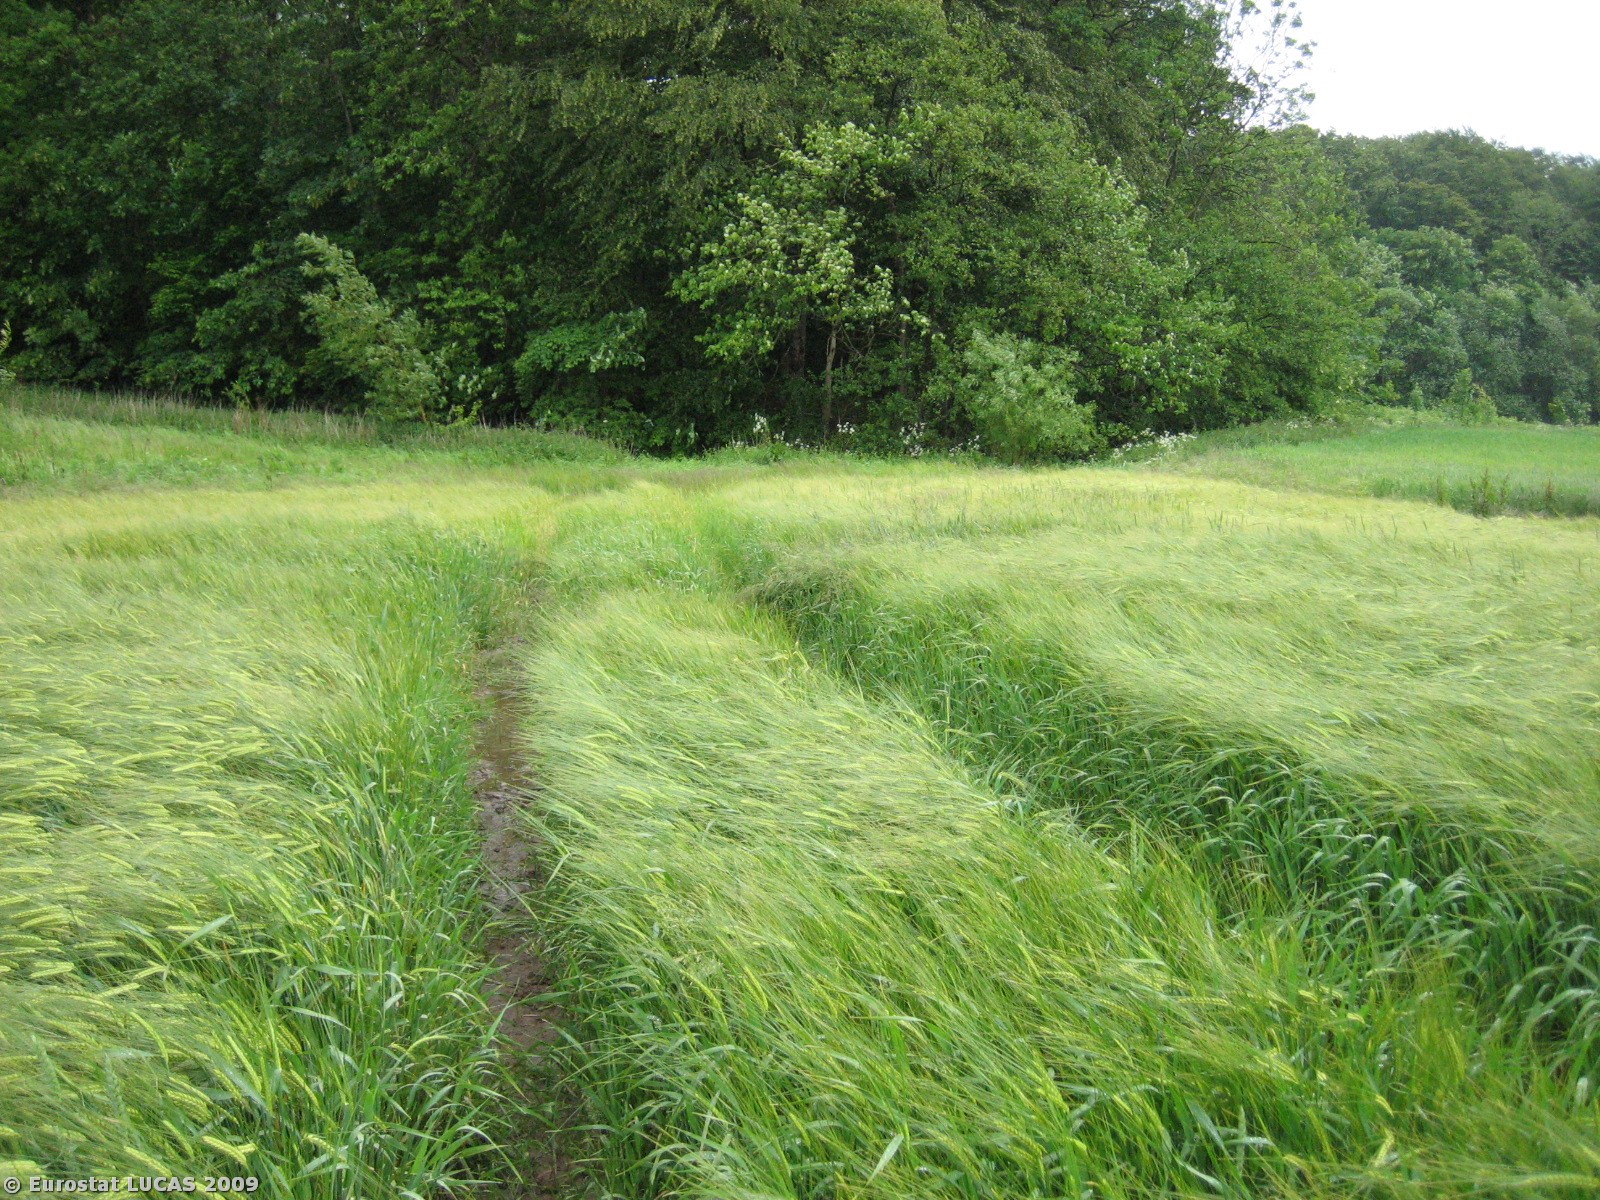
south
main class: Cropland
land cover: Barley
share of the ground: > 75 %
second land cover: Common wheat
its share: < 10 %
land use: Agriculture (excluding fallow land and kitchen gardens)
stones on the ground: < 10 %
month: June
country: DK
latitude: 55.9900
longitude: 10.0160
